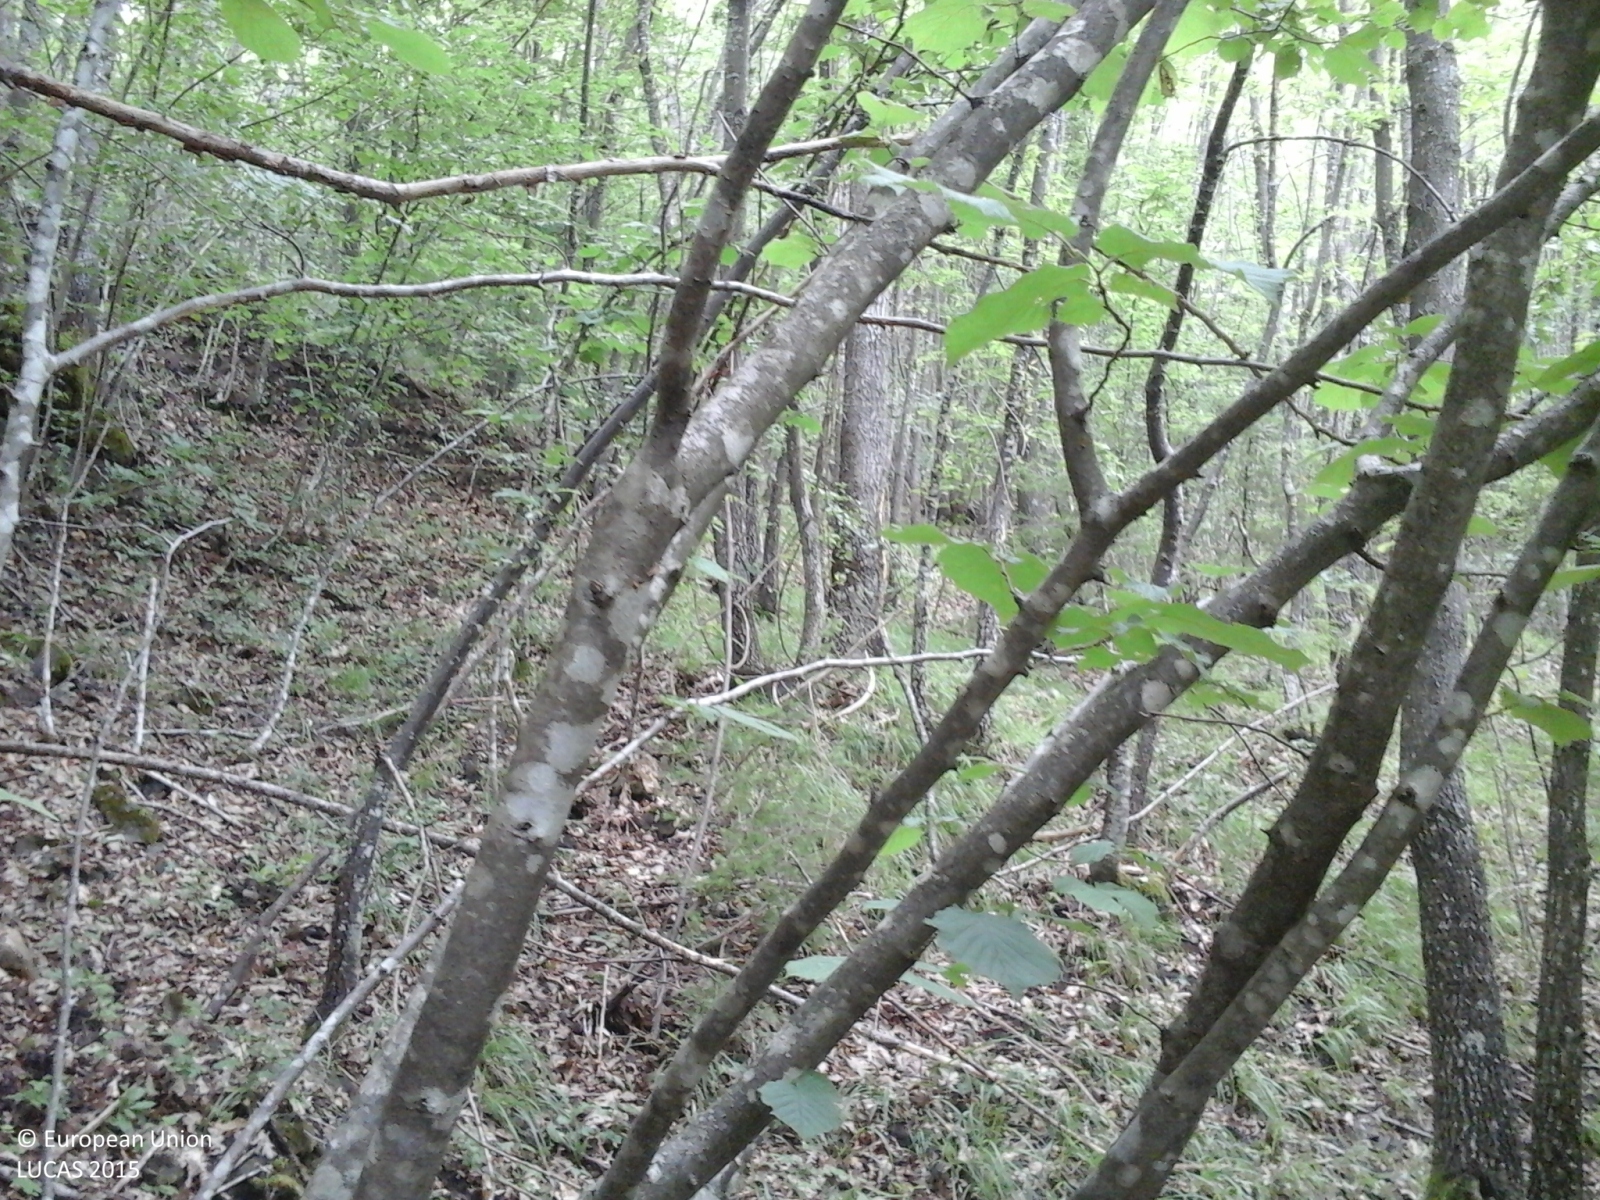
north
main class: Woodland
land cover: Broadleaved woodland
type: mountainous beech forest
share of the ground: > 75 %
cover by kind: broadleaved forest trees 100 %
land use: Forestry
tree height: > 5 m
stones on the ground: 10 - 25 %
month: June
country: IT
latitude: 44.5842
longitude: 9.5853
